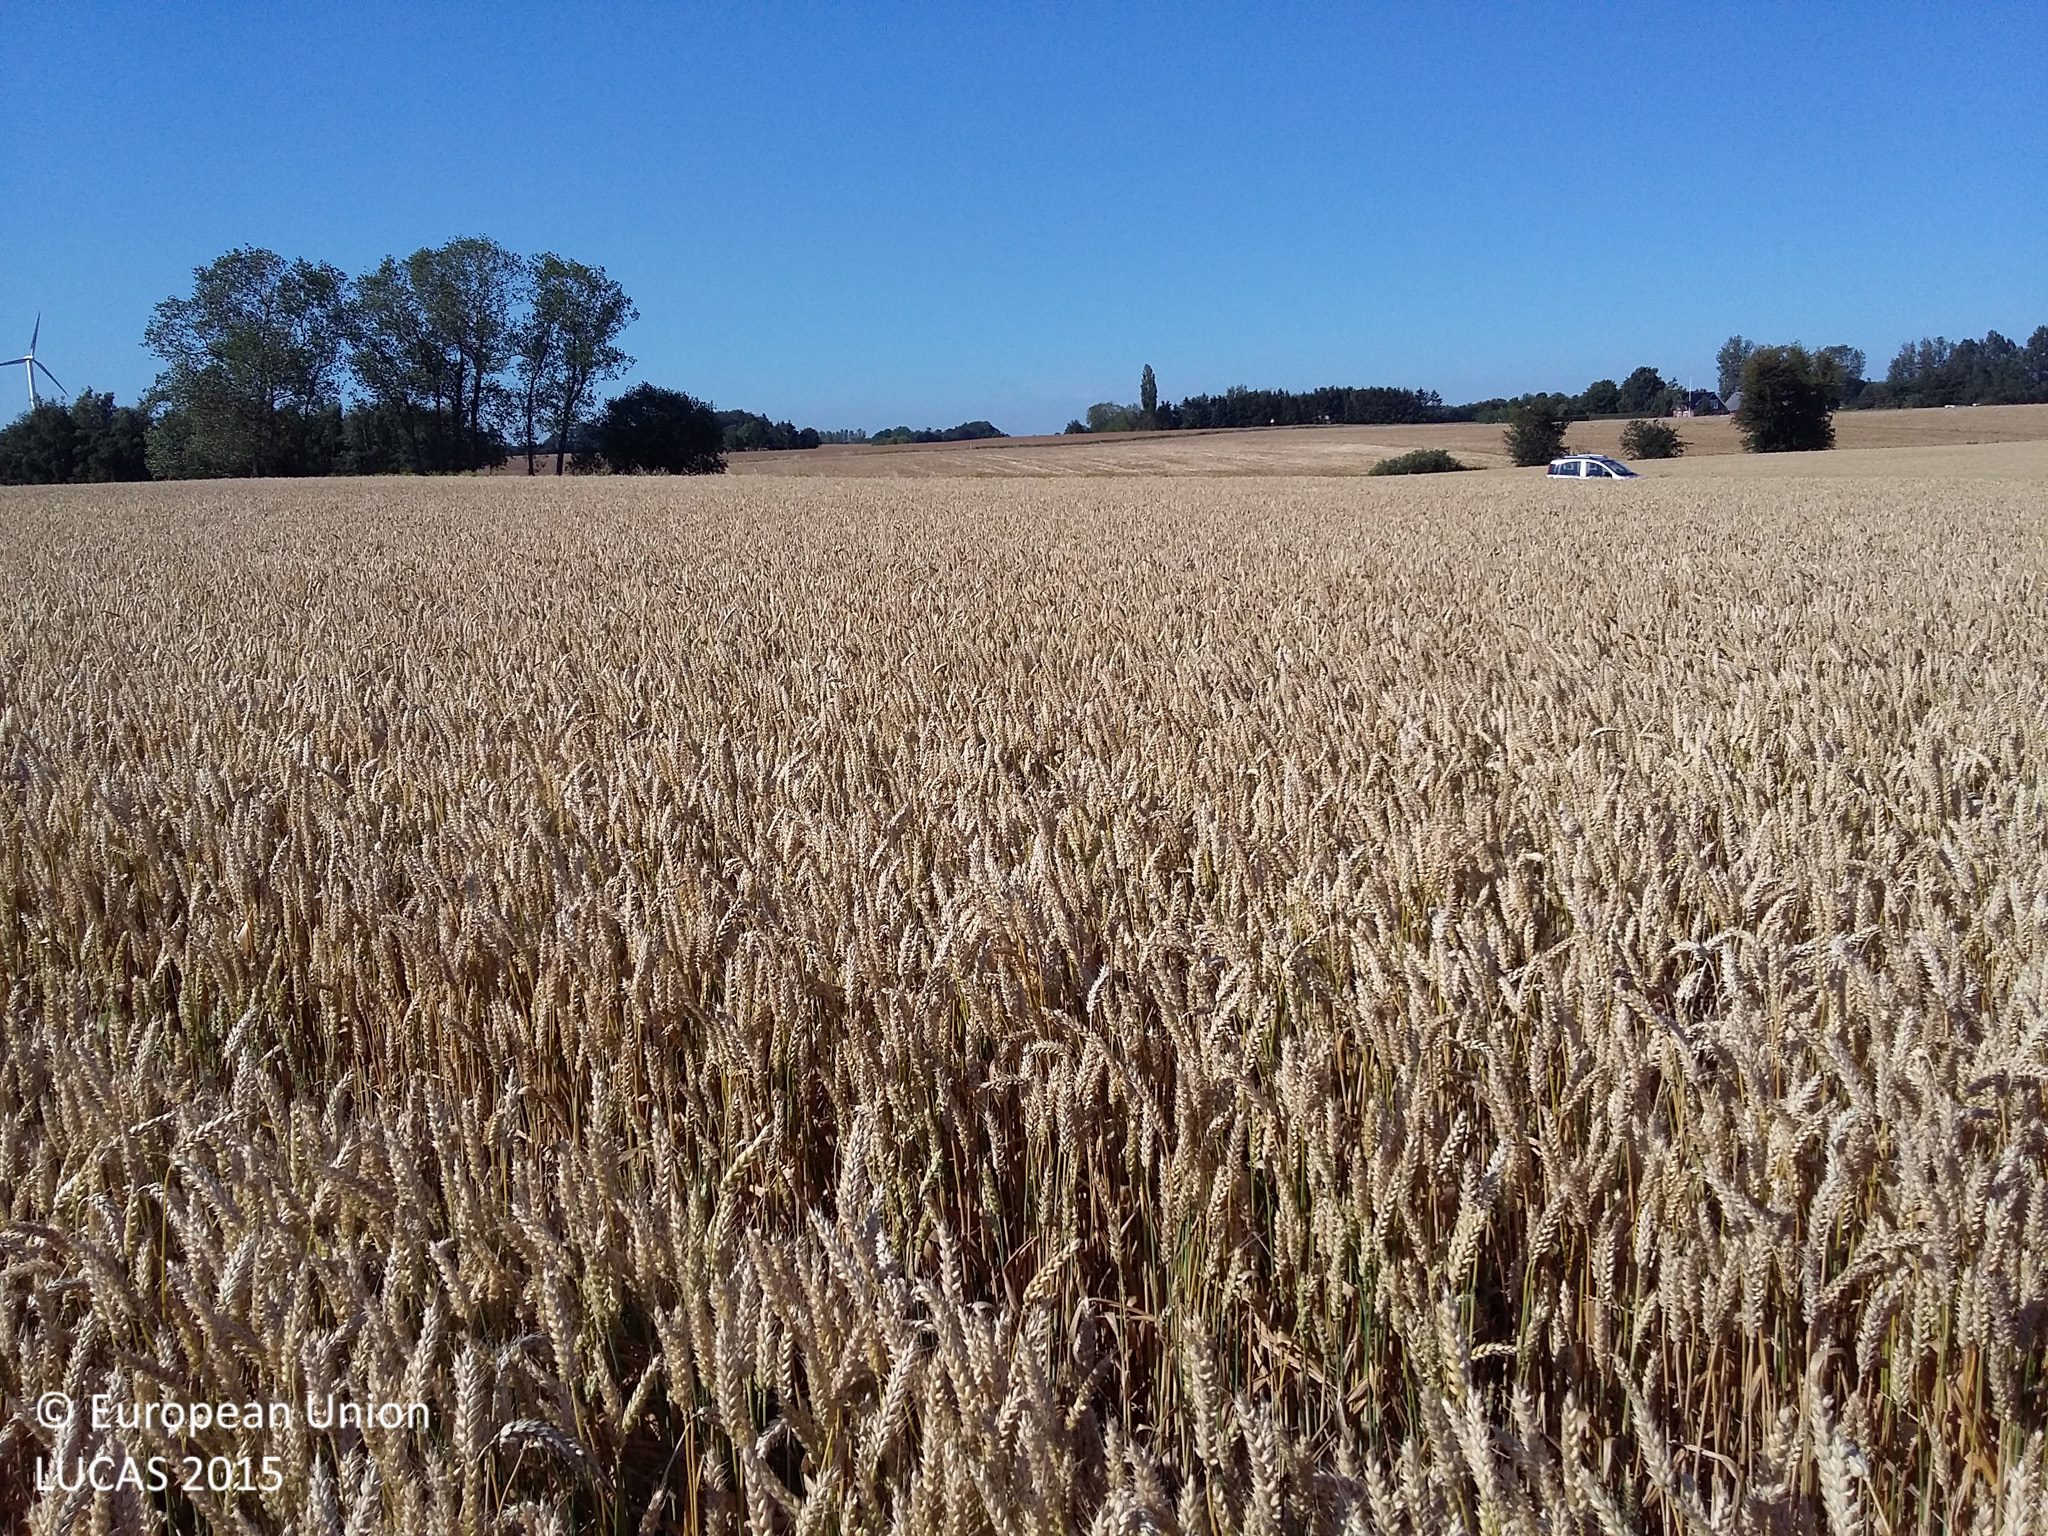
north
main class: Cropland
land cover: Common wheat
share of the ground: > 75 %
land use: Agriculture (excluding fallow land and kitchen gardens)
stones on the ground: < 10 %
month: August
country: DK
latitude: 55.6664
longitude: 12.1444
